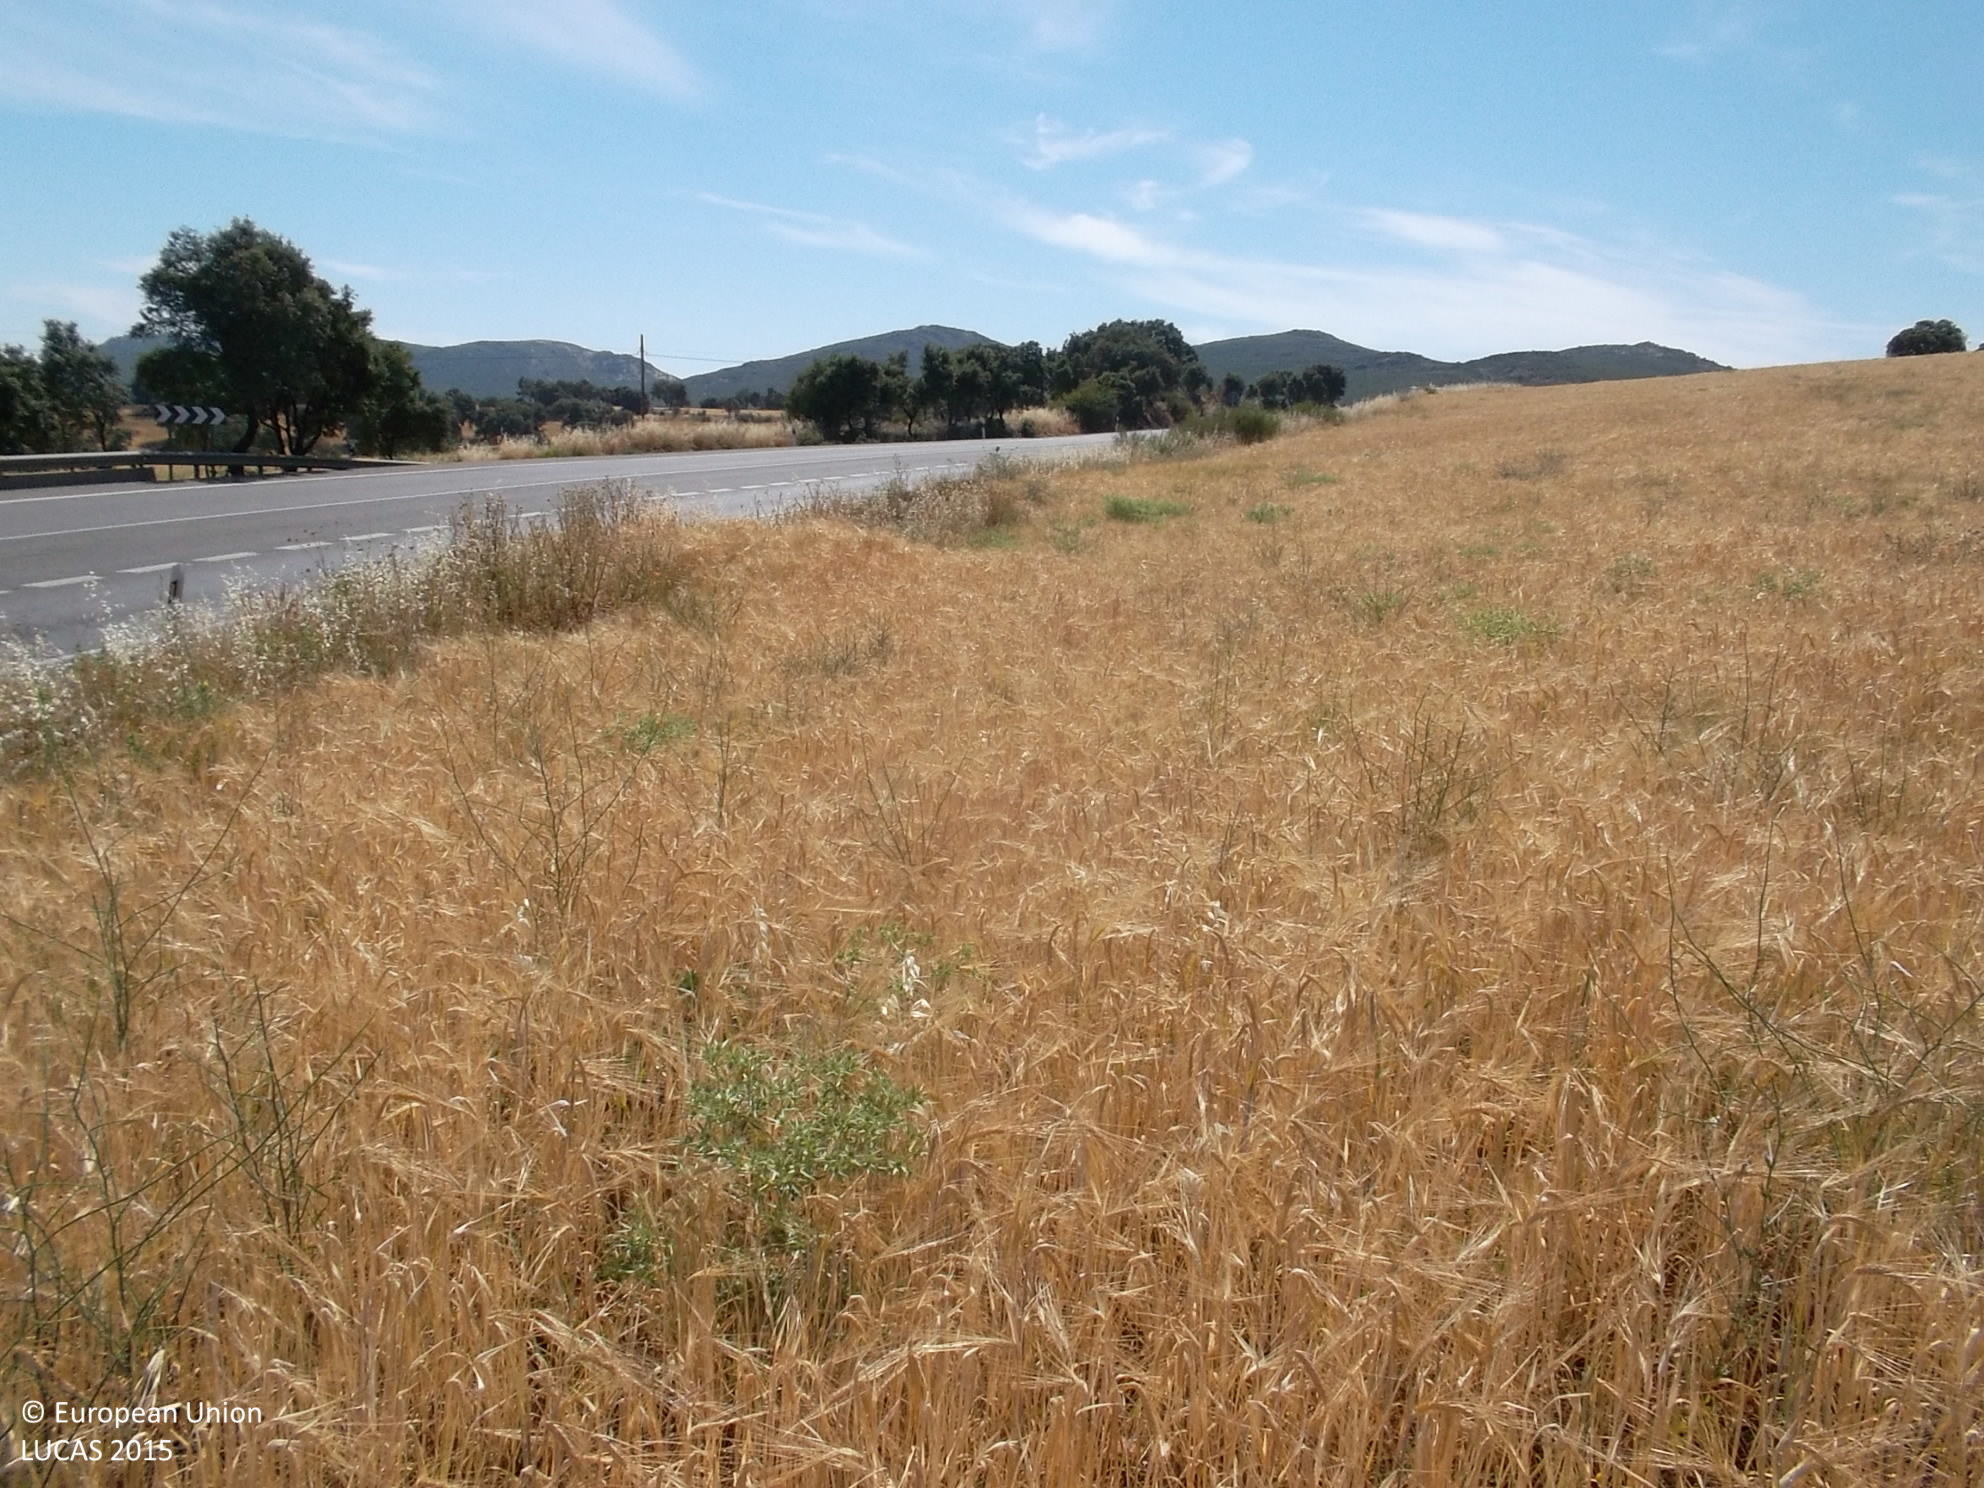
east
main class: Cropland
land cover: Barley
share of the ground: 25 - 50 %
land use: Agriculture (excluding fallow land and kitchen gardens)
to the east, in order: Barley; Paved roads, cycling and walking lanes; Grass margins; Groves; Barley; Electric lines; Barley
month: June
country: ES
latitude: 39.0339
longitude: -4.1524
